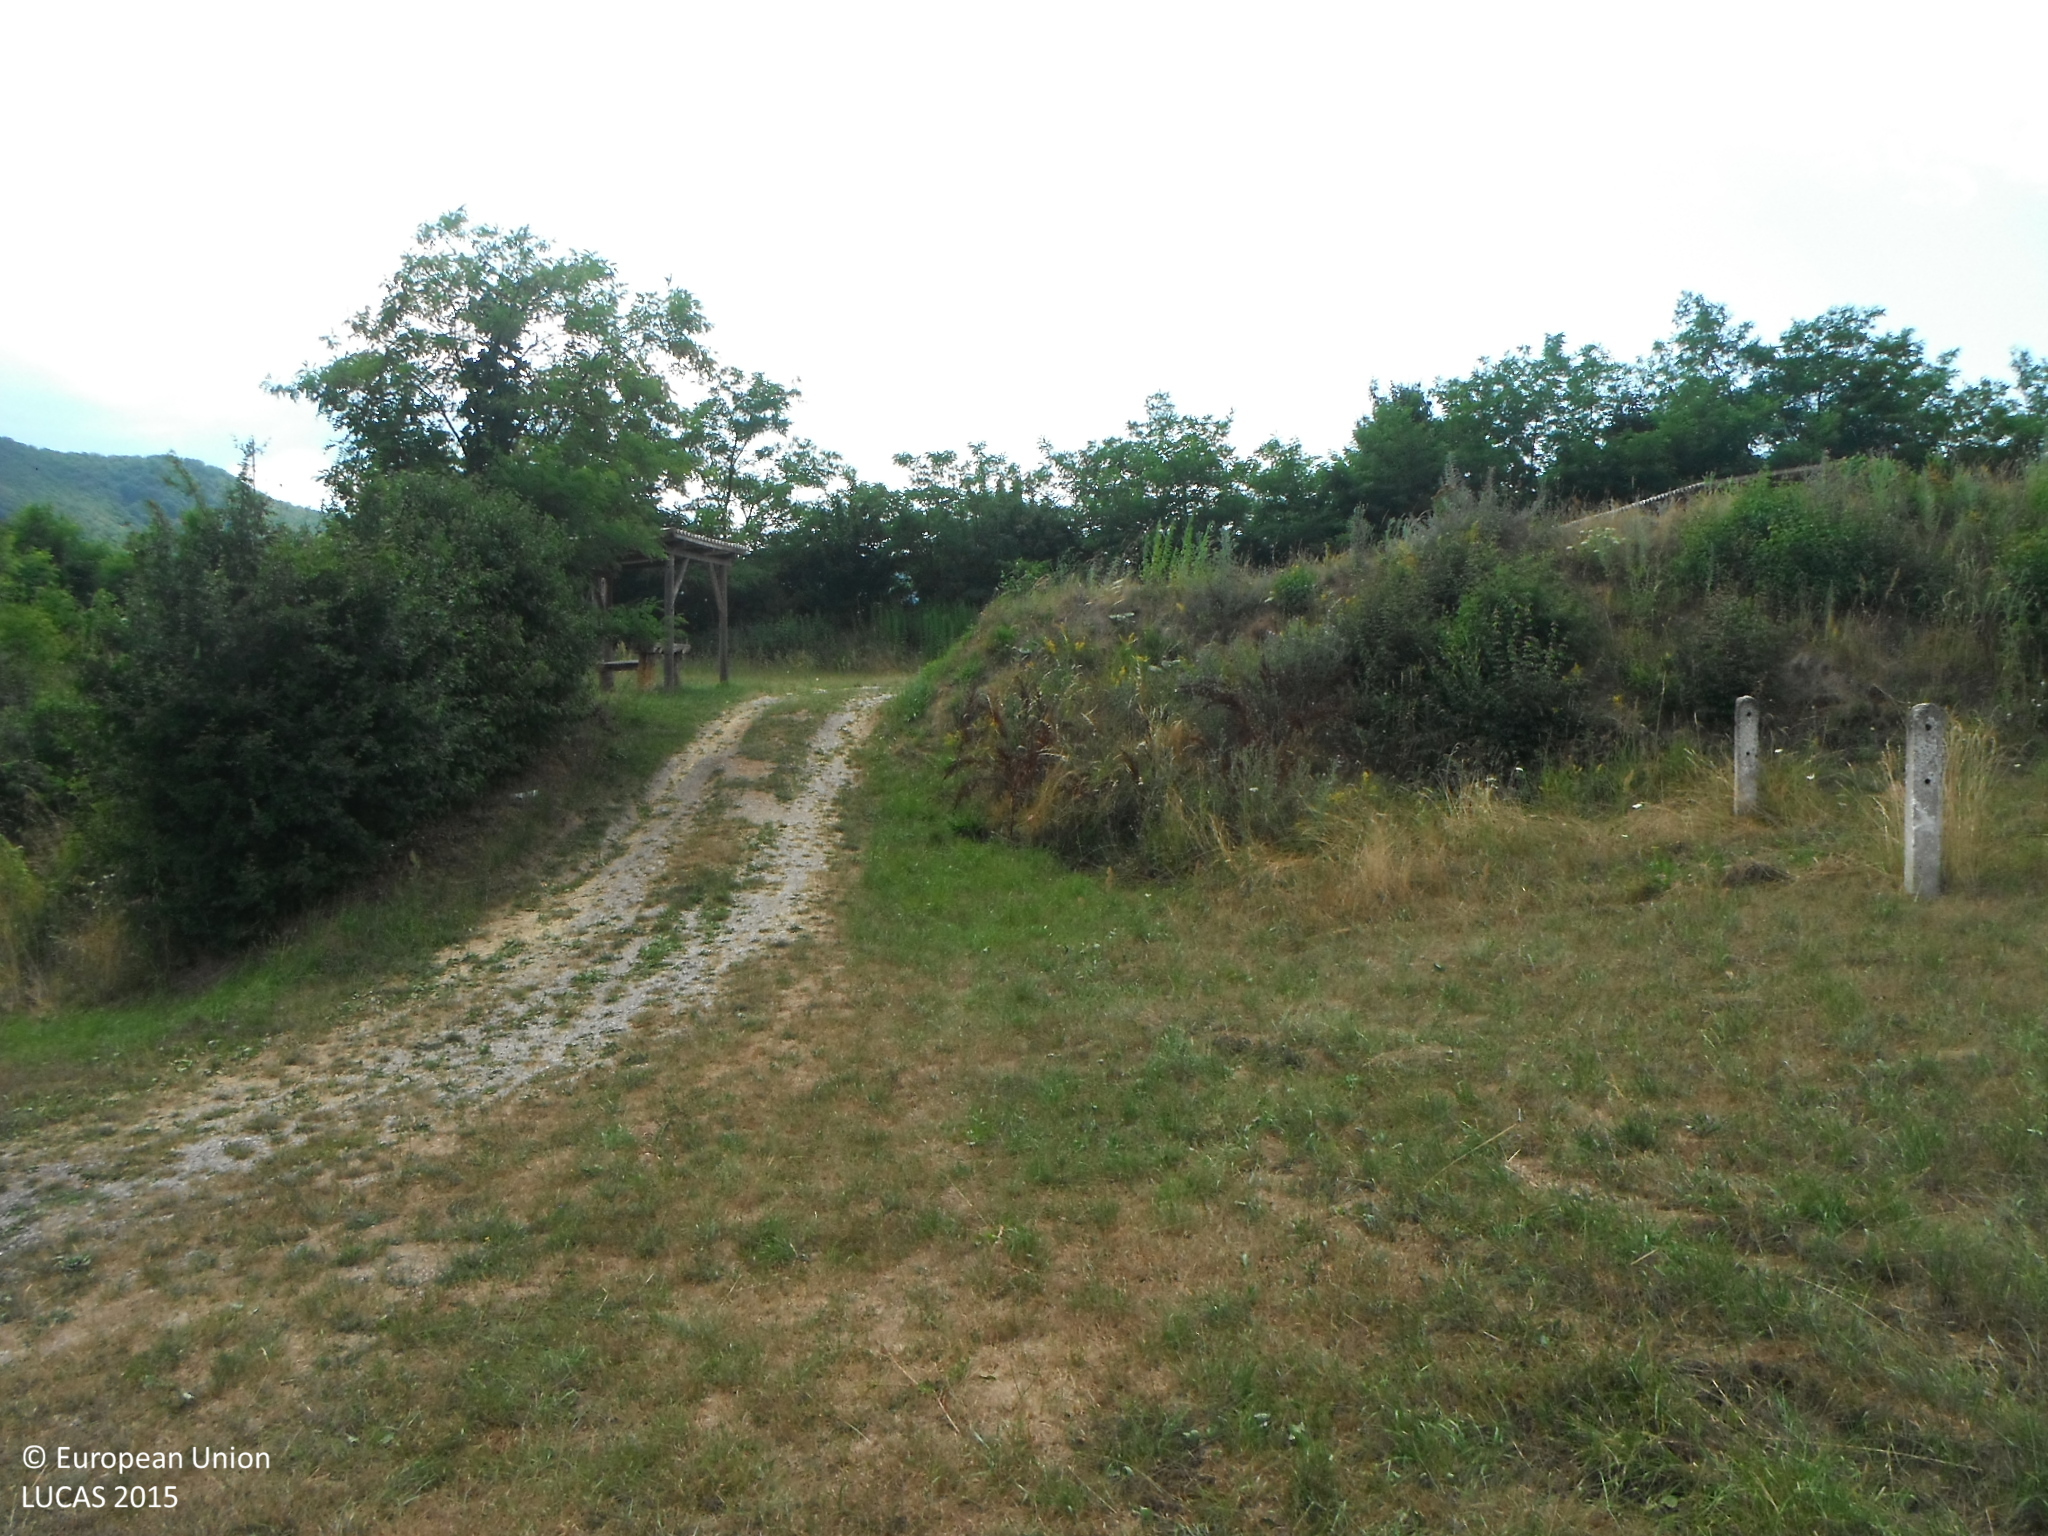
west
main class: Grassland
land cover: Grassland without tree/shrub cover
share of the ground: > 75 %
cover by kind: herbaceous plants 100 %
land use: Amenities, museums, leisure
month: July
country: SK
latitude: 48.6332
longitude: 20.2502
